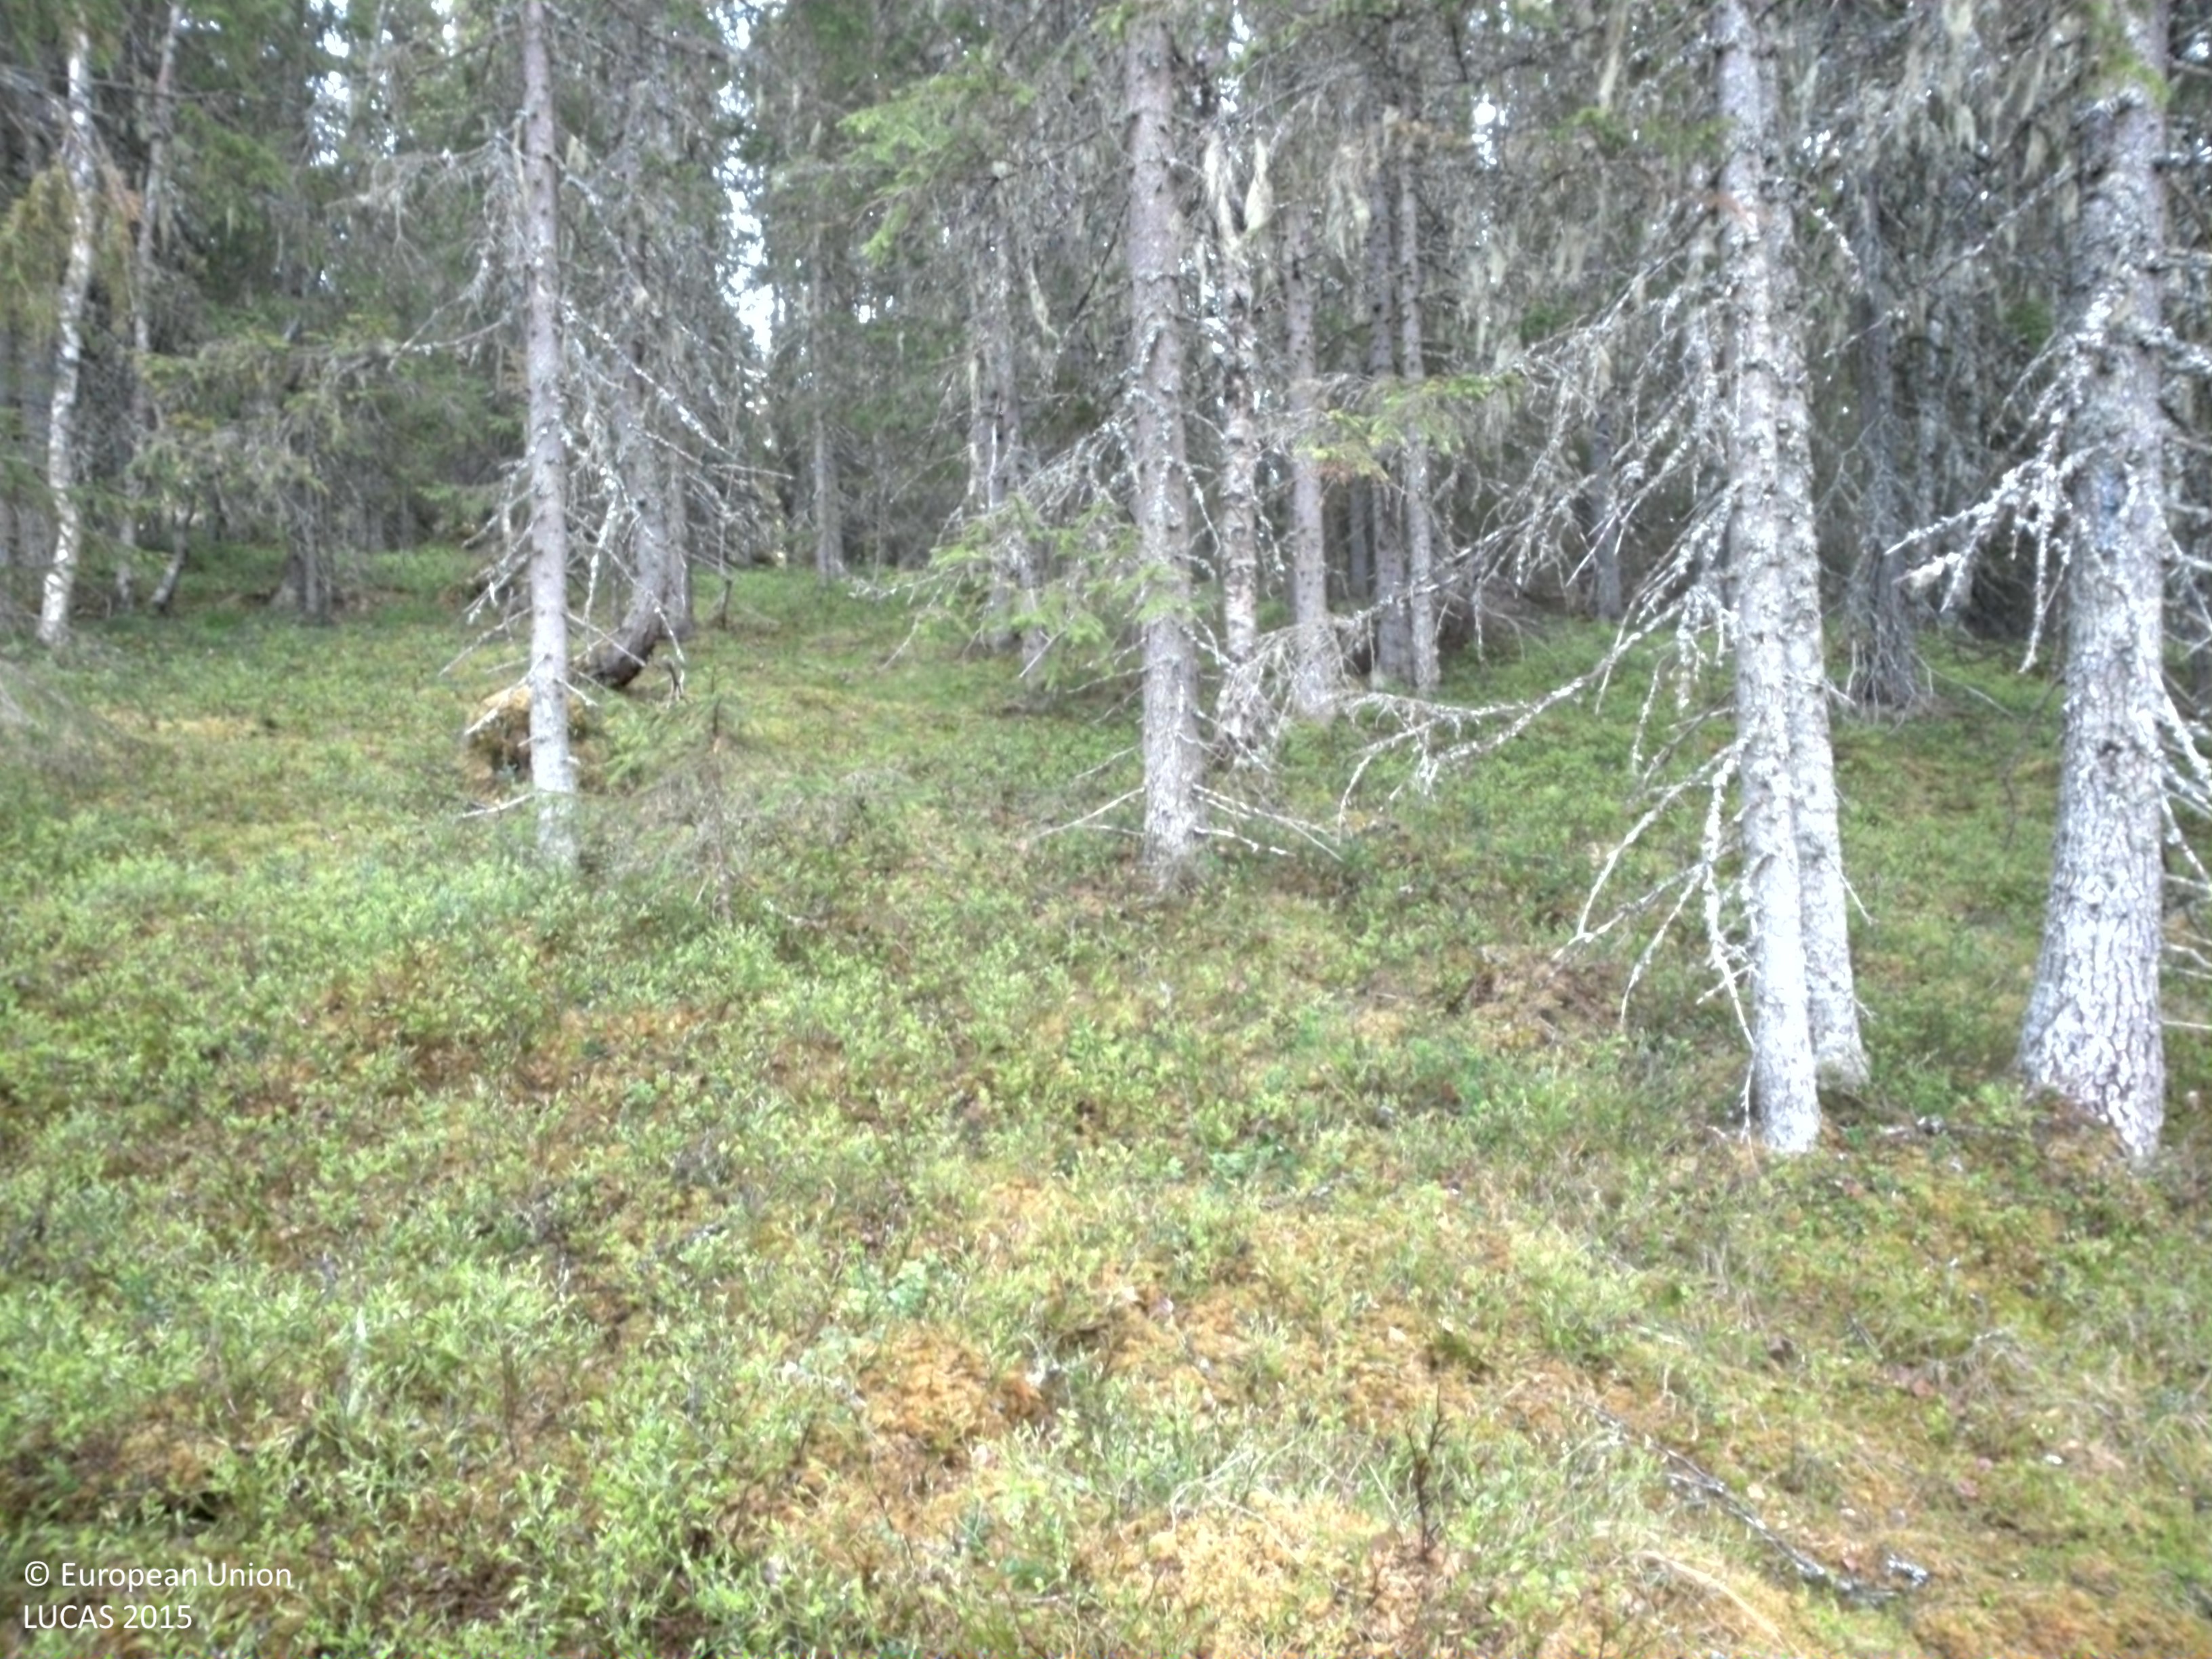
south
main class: Woodland
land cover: Spruce dominated coniferous woodland
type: boreal forest
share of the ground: 50 - 75 %
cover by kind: coniferous forest trees 50 %, herbaceous plants 30 %, lichens and mosses 15 %, broadleaved forest trees 5 %
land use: Forestry
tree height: > 5 m
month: June
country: SE
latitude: 64.2293
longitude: 17.6998
